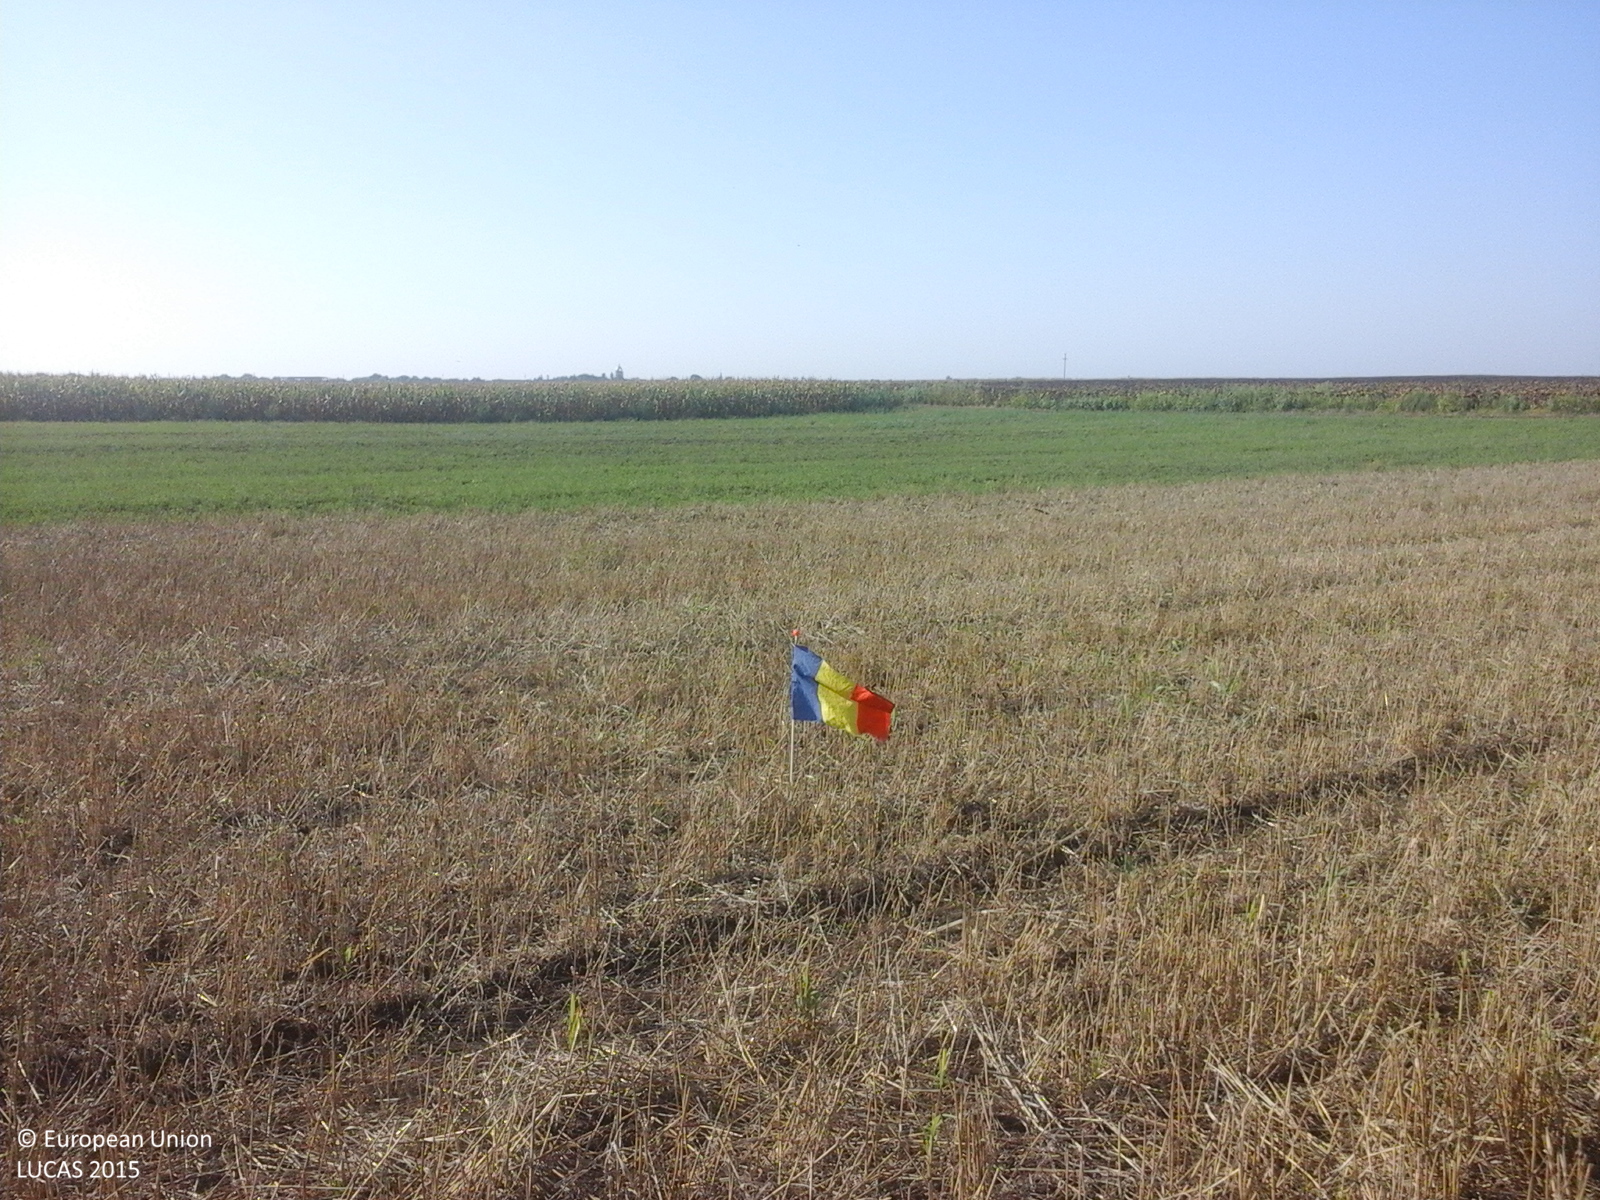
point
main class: Cropland
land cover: Common wheat
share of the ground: > 75 %
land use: Agriculture (excluding fallow land and kitchen gardens)
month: August
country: RO
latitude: 45.7518
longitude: 20.9413
